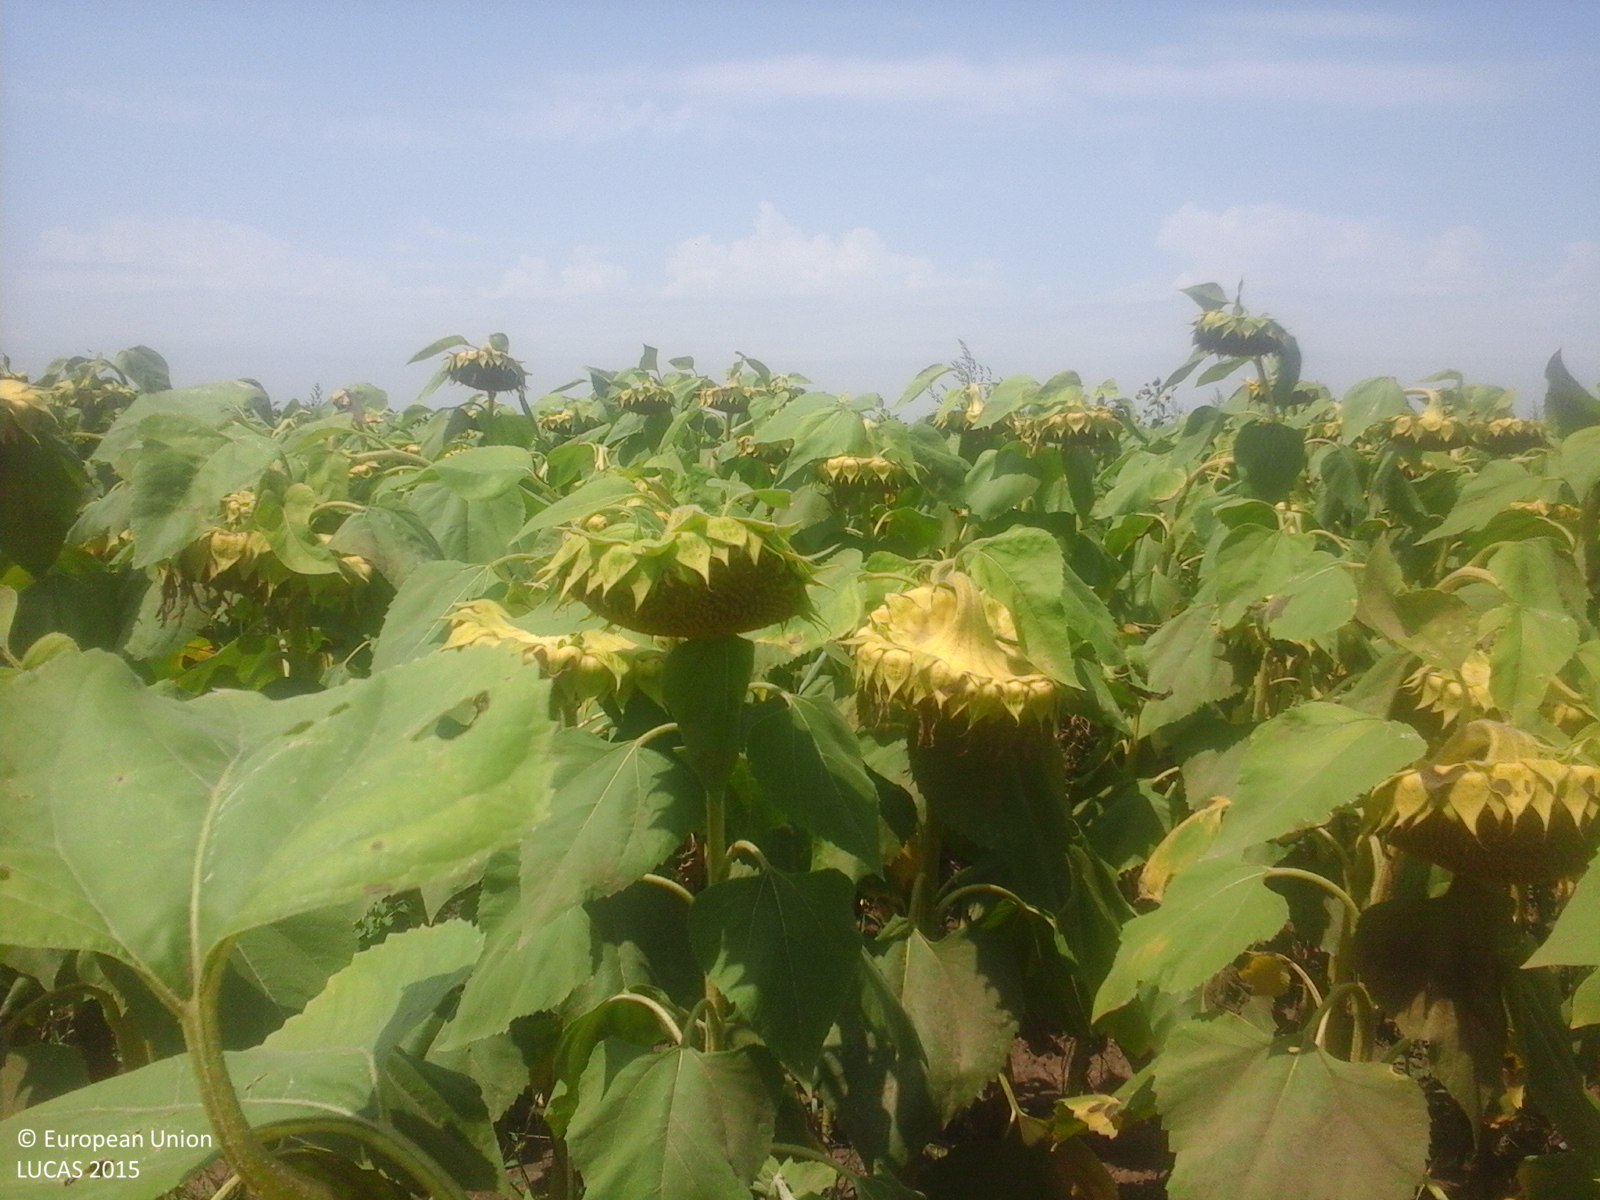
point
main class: Cropland
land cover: Sunflower
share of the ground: > 75 %
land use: Agriculture (excluding fallow land and kitchen gardens)
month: August
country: RO
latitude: 43.8359
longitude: 28.1759
